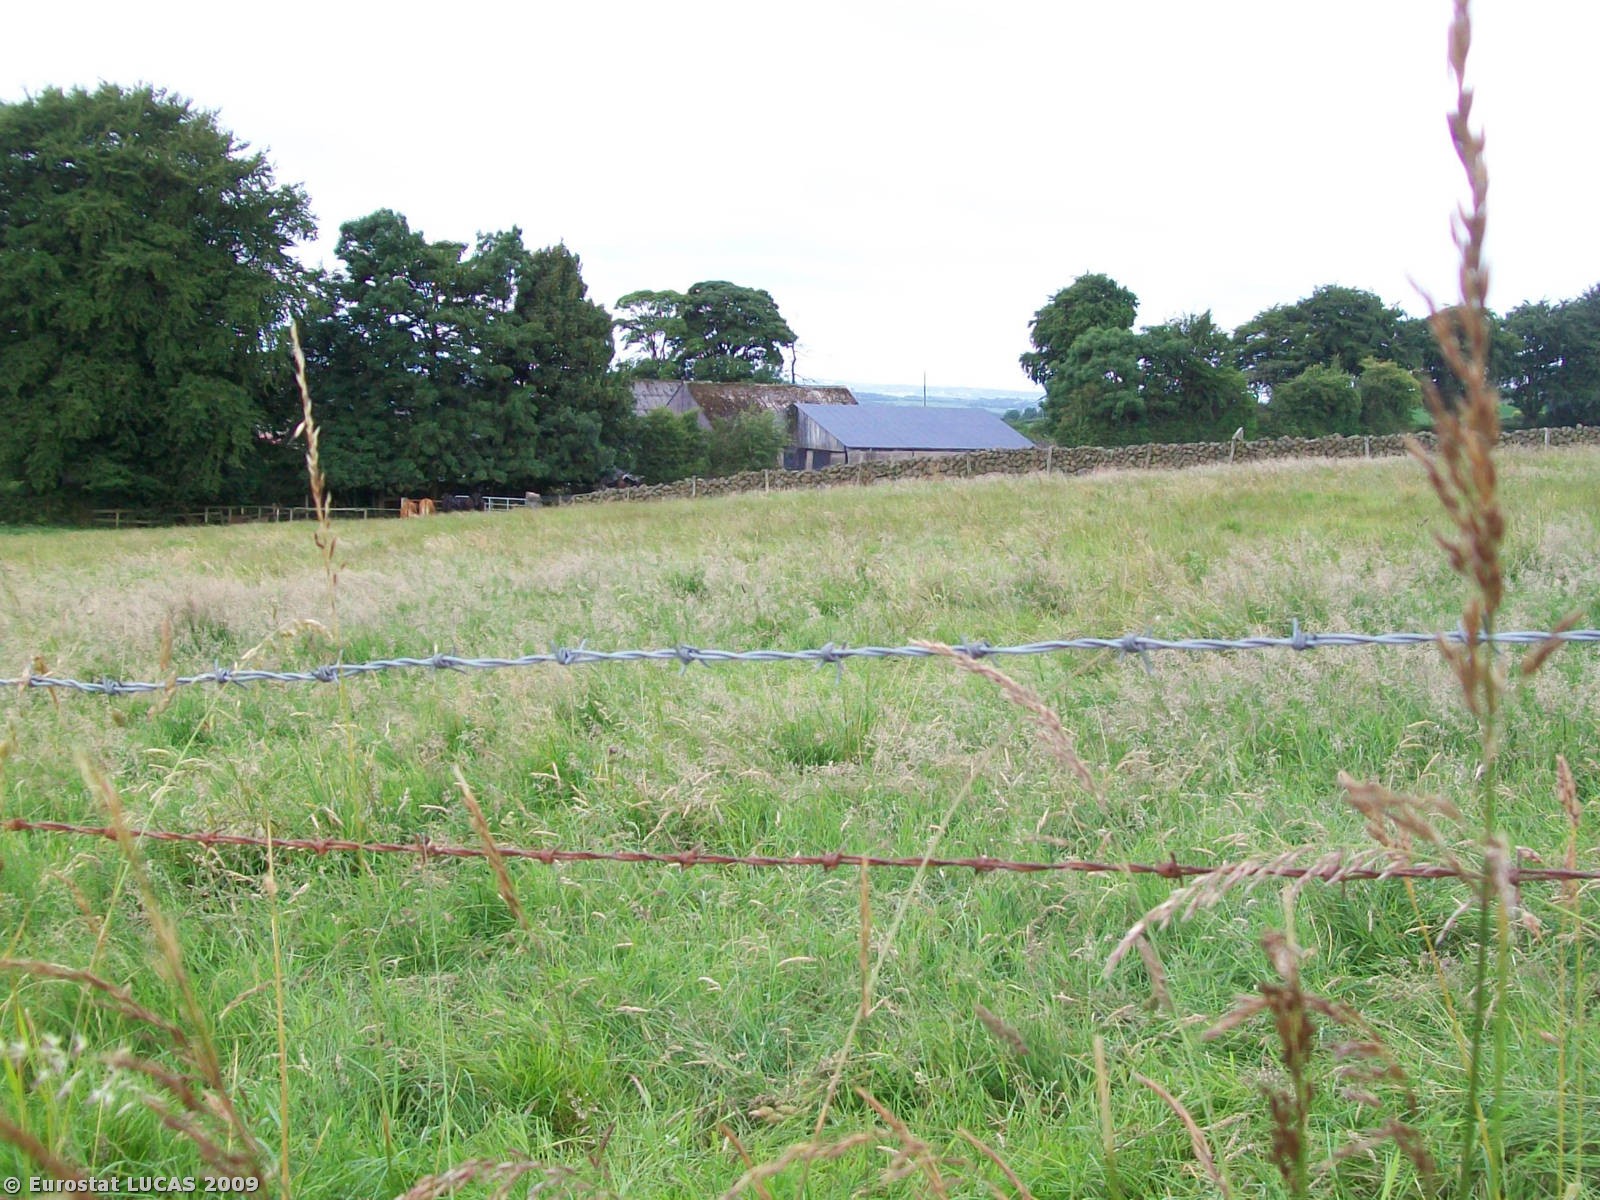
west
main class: Grassland
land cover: Grassland without tree/shrub cover
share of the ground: > 75 %
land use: Agriculture (excluding fallow land and kitchen gardens)
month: July
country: GB
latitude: 54.9230
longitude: -6.2331
